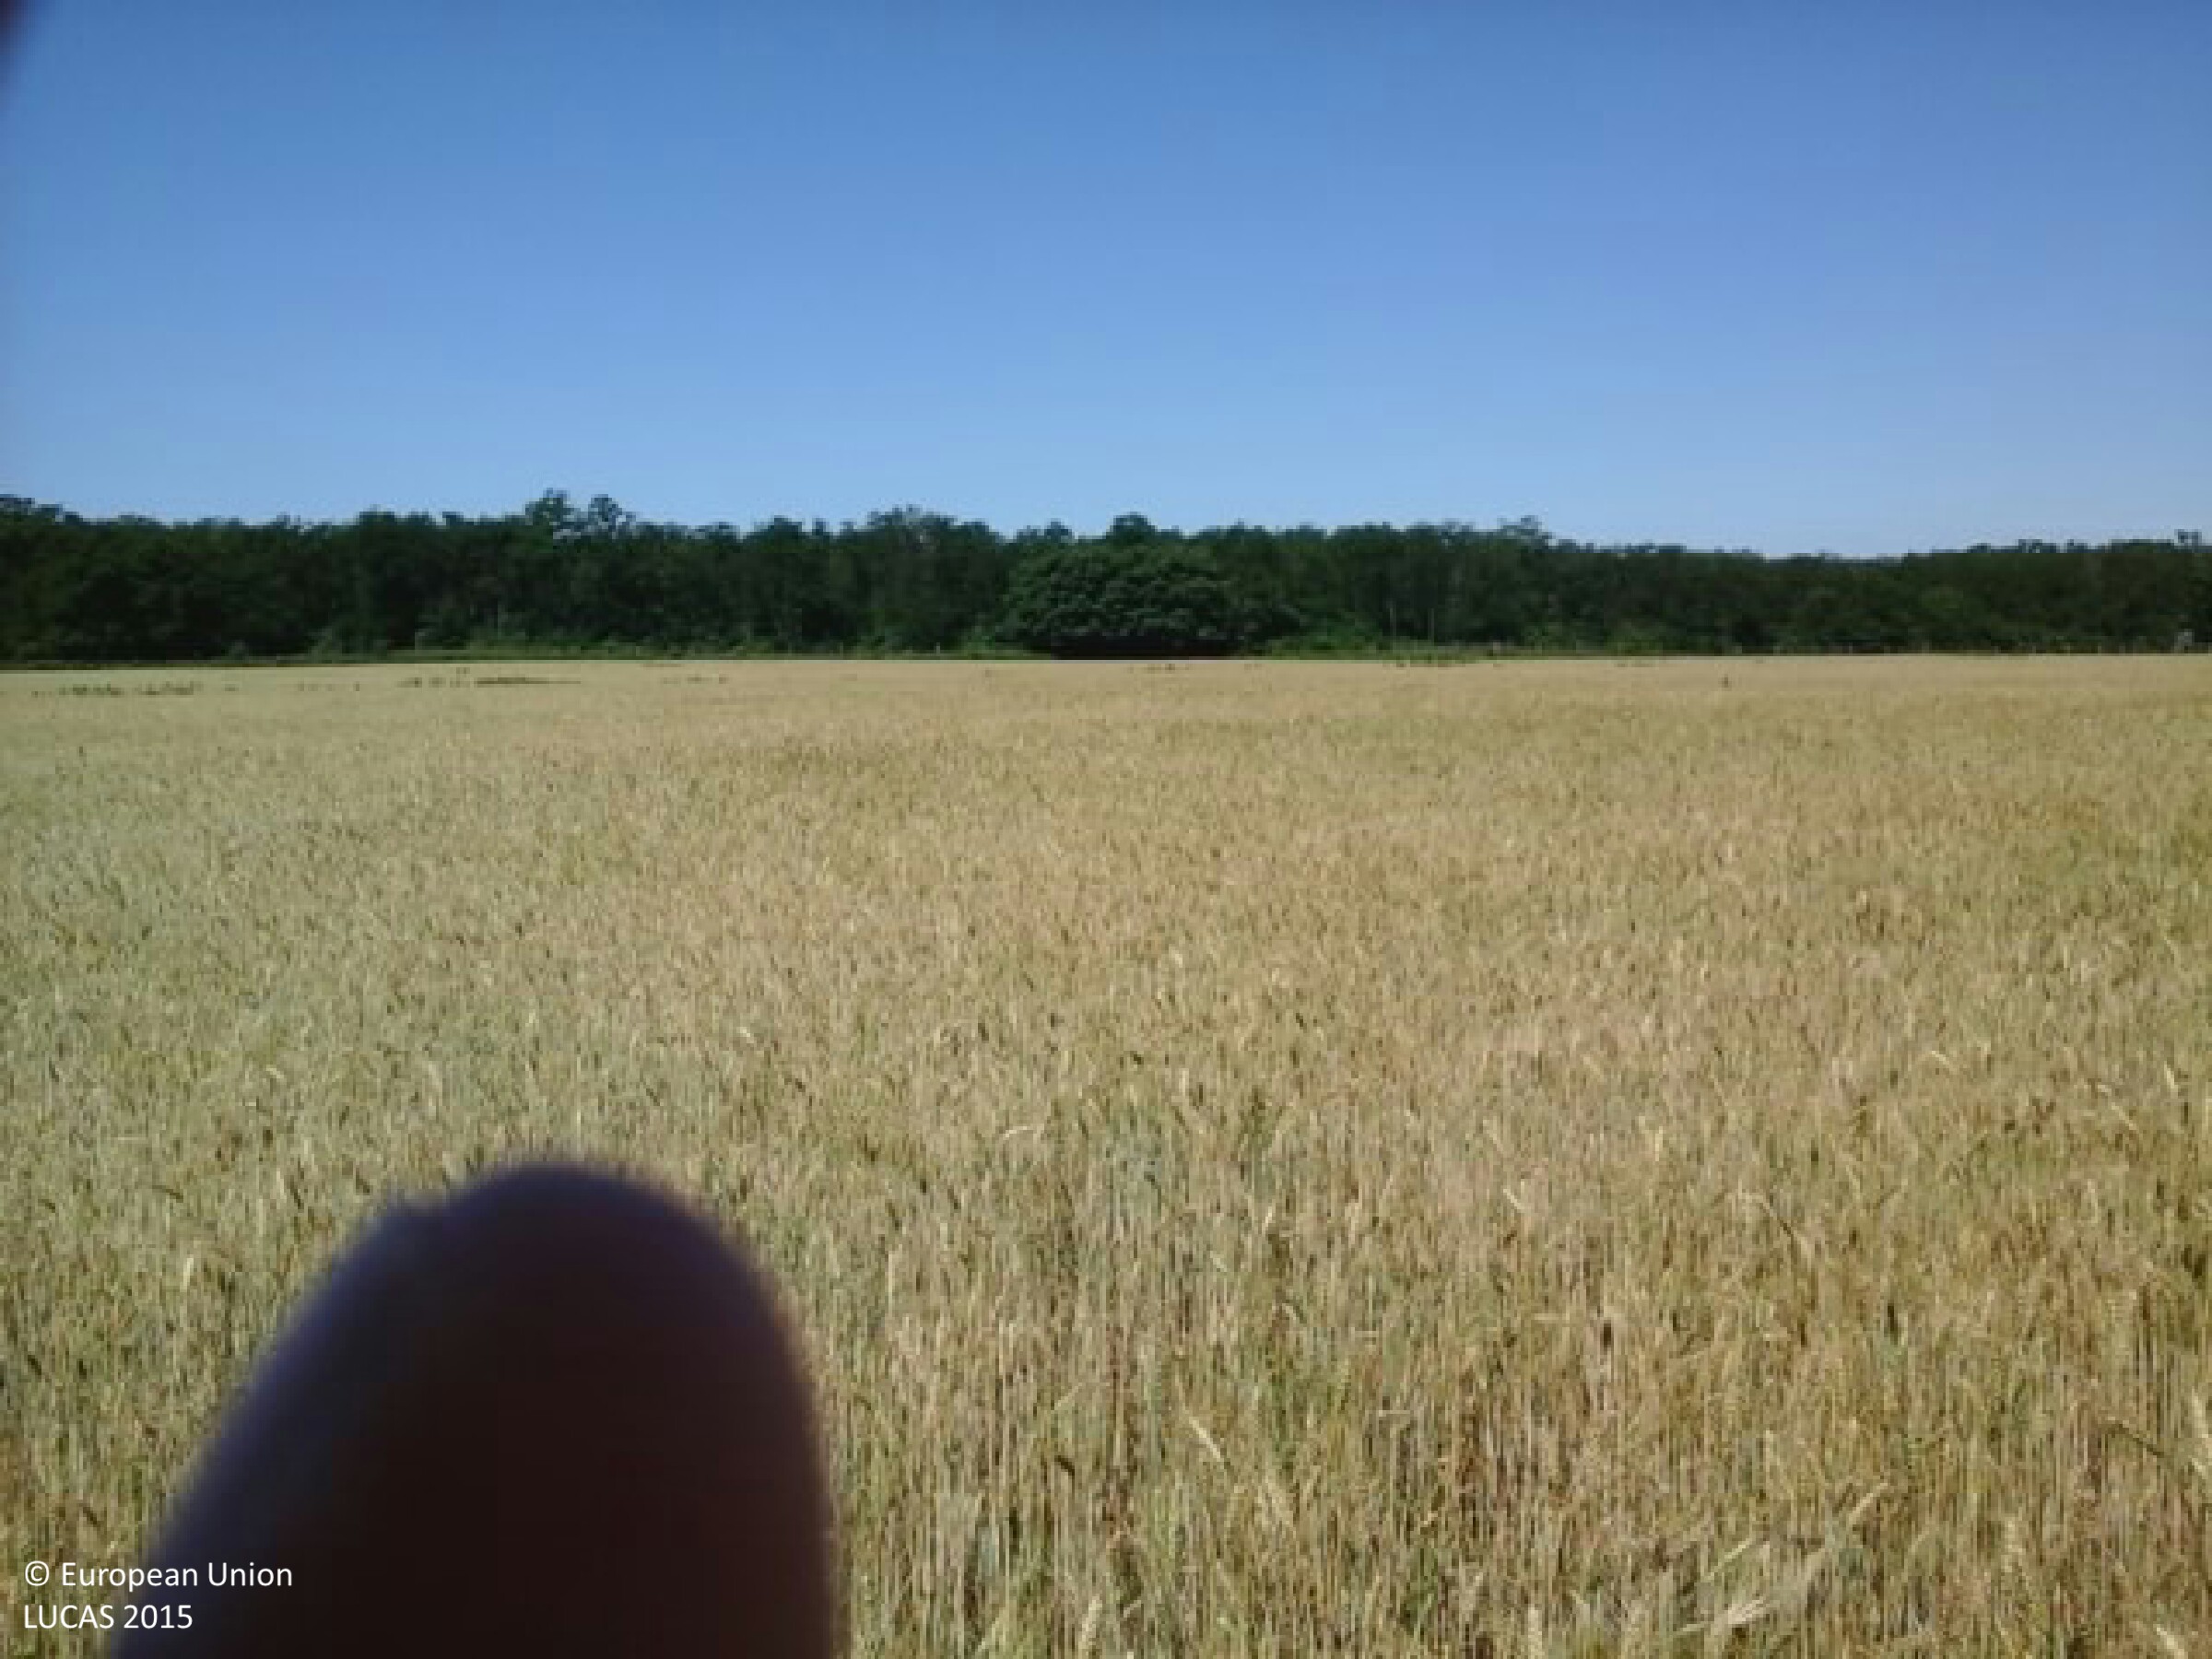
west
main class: Cropland
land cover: Common wheat
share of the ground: > 75 %
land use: Agriculture (excluding fallow land and kitchen gardens)
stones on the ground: < 10 %
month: June
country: HU
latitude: 46.3525
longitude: 19.2021
